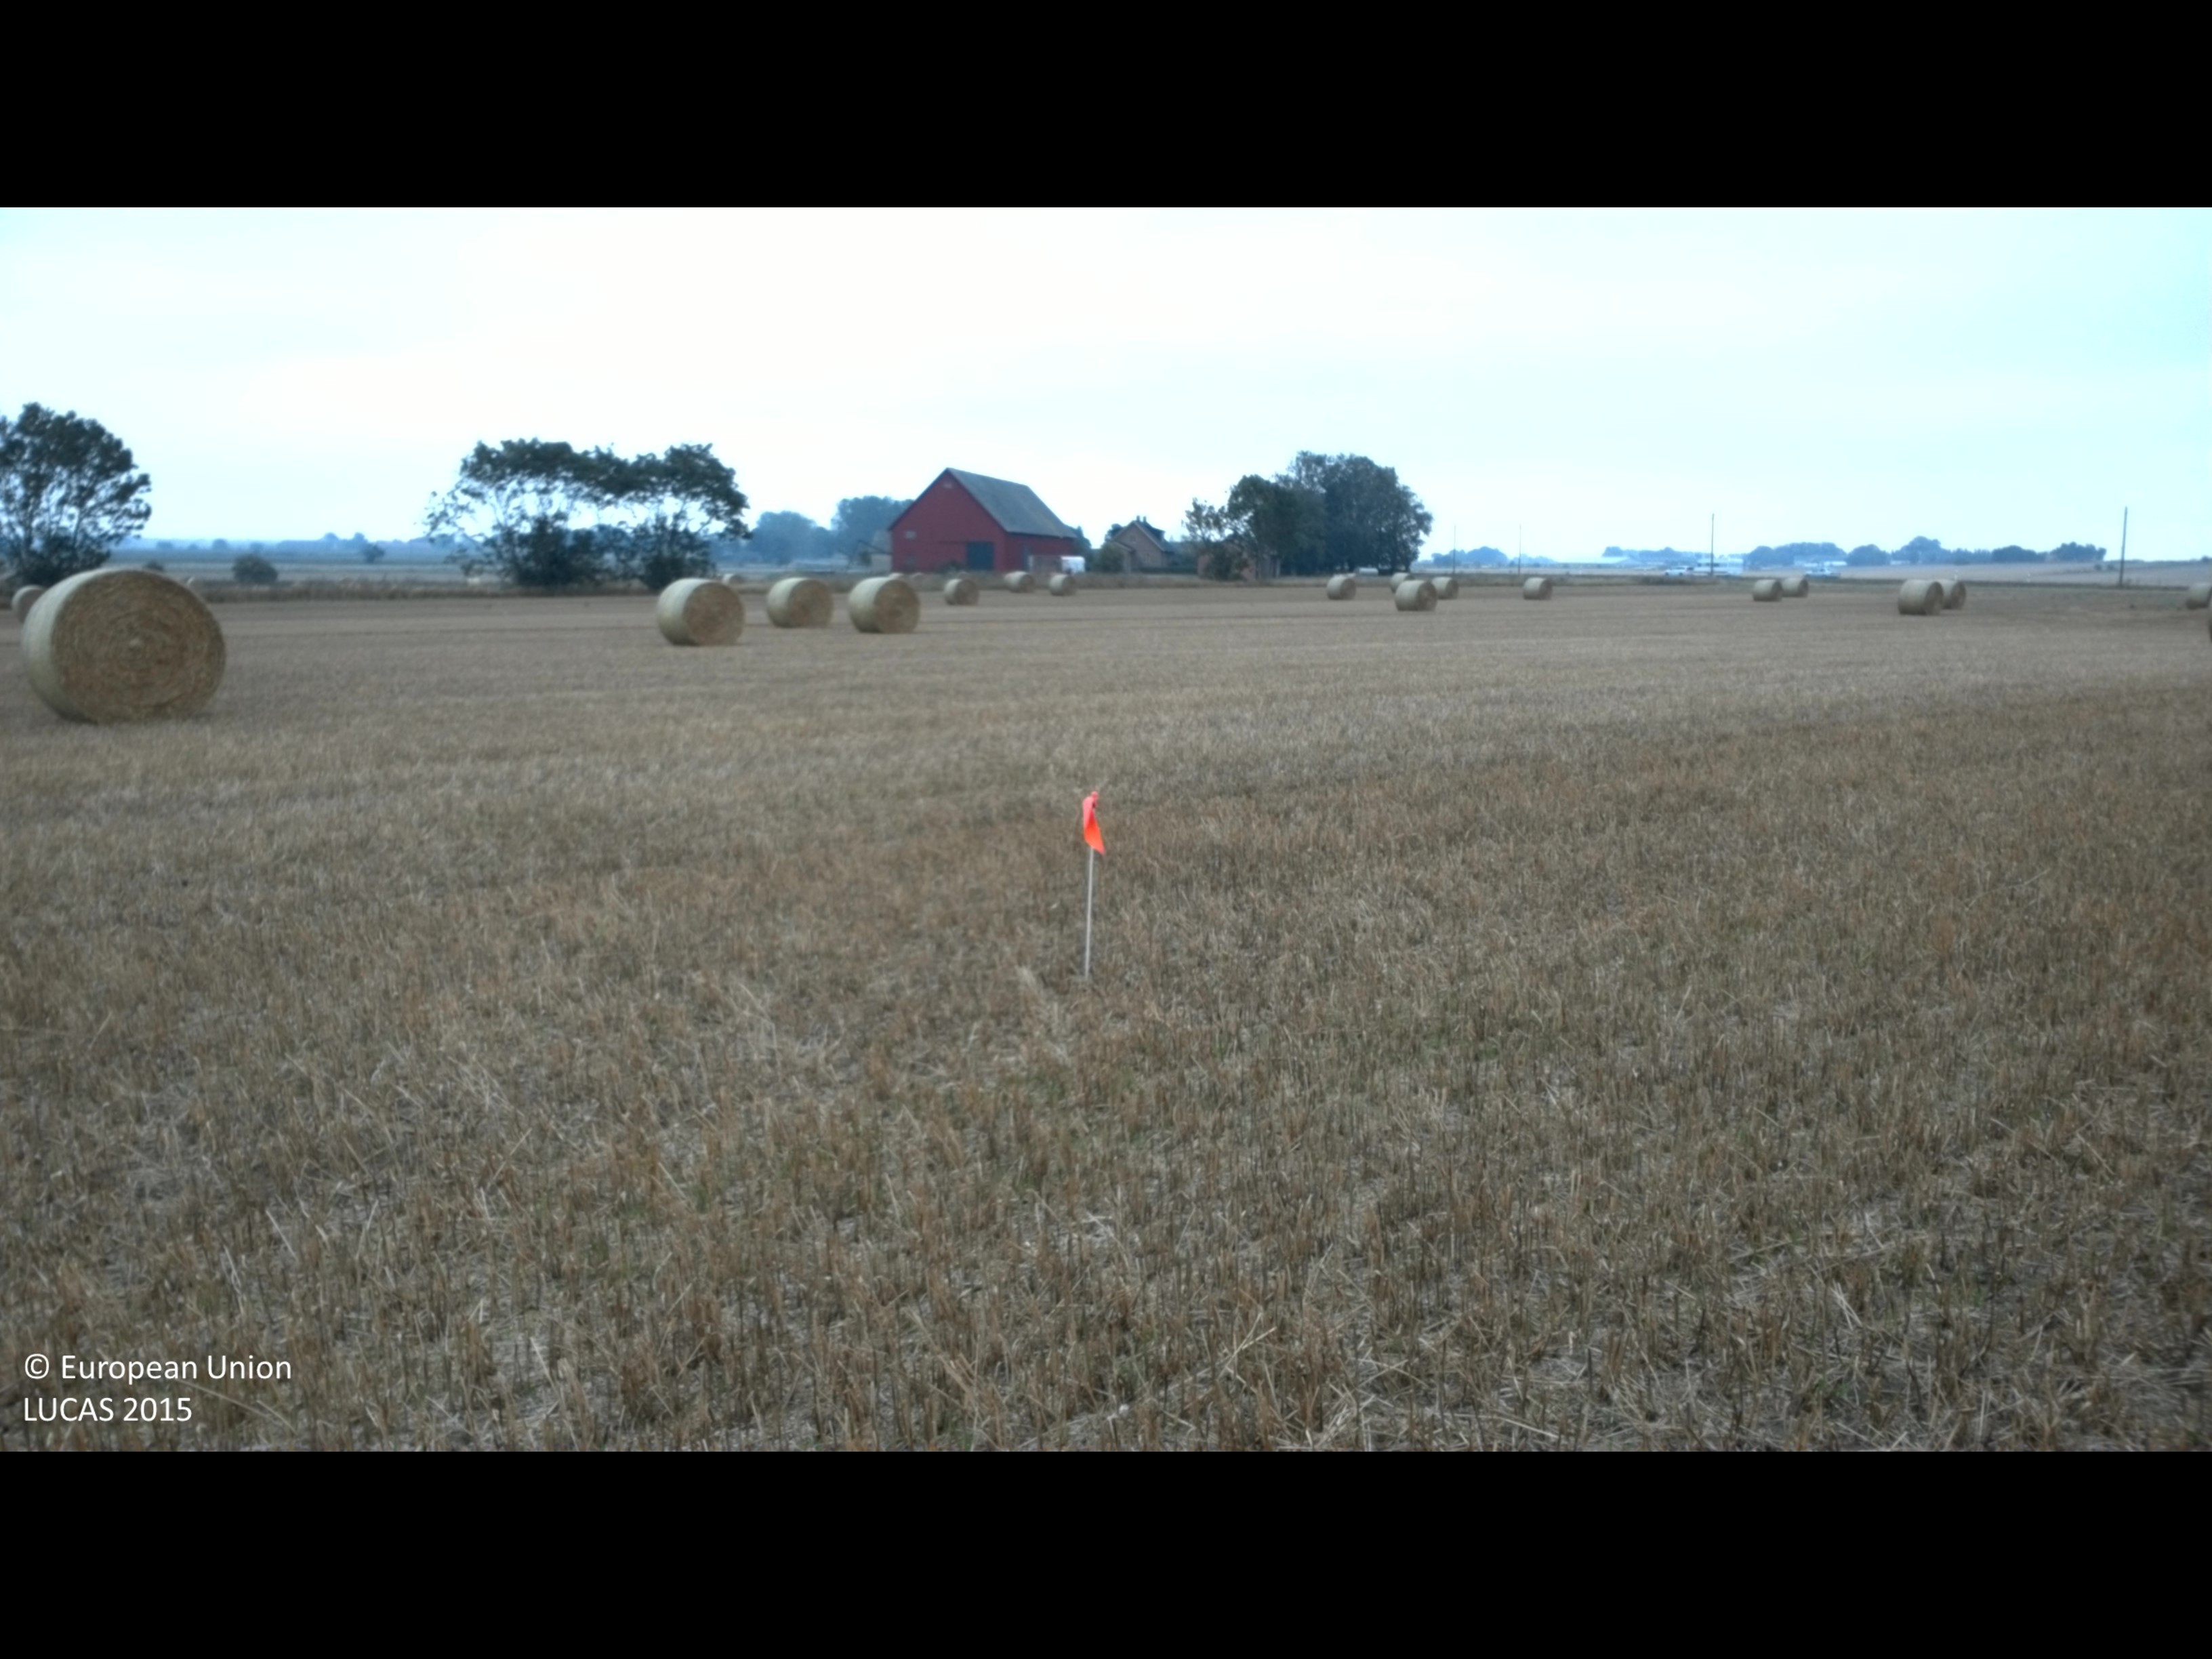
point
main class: Cropland
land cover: Common wheat
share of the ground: > 75 %
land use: Agriculture (excluding fallow land and kitchen gardens)
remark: Harvested field
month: September
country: SE
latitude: 55.9757
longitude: 14.1805
